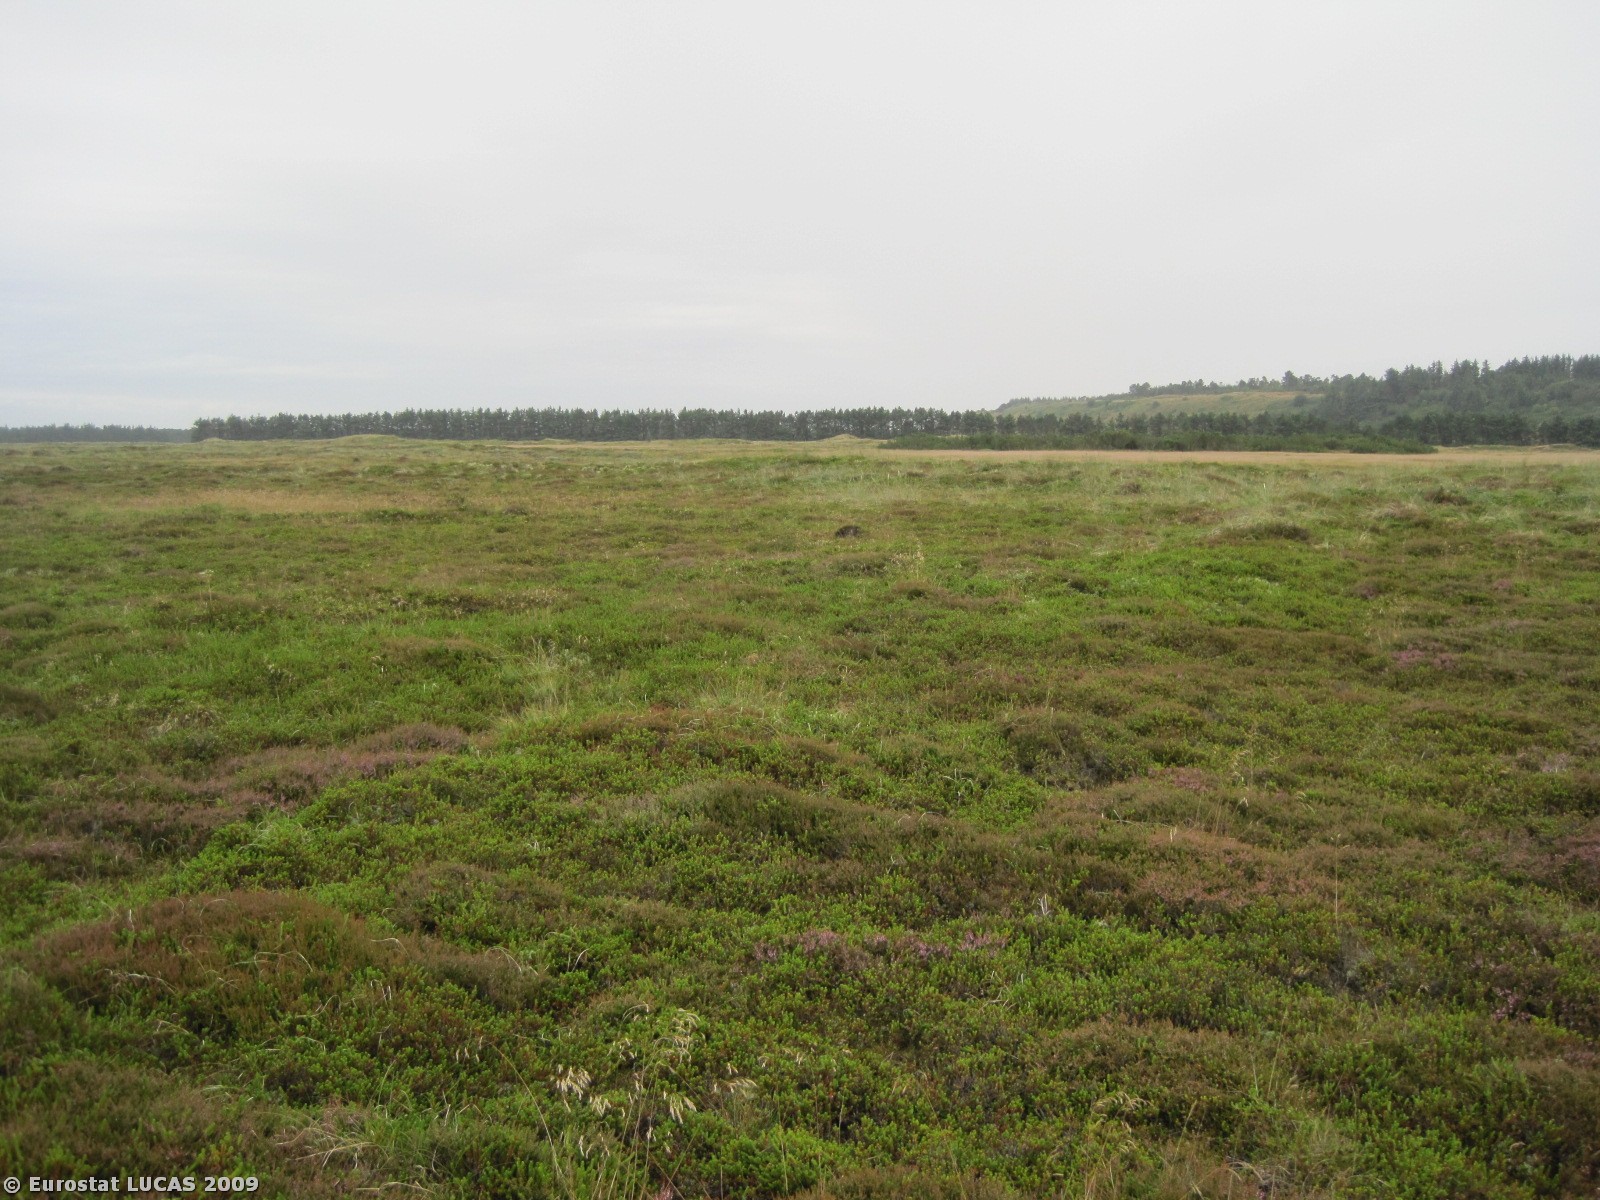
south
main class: Grassland
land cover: Grassland without tree/shrub cover
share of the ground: > 75 %
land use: Nature reserves
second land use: Amenities, museums, leisure
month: July
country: DK
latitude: 57.0984
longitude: 8.7309
